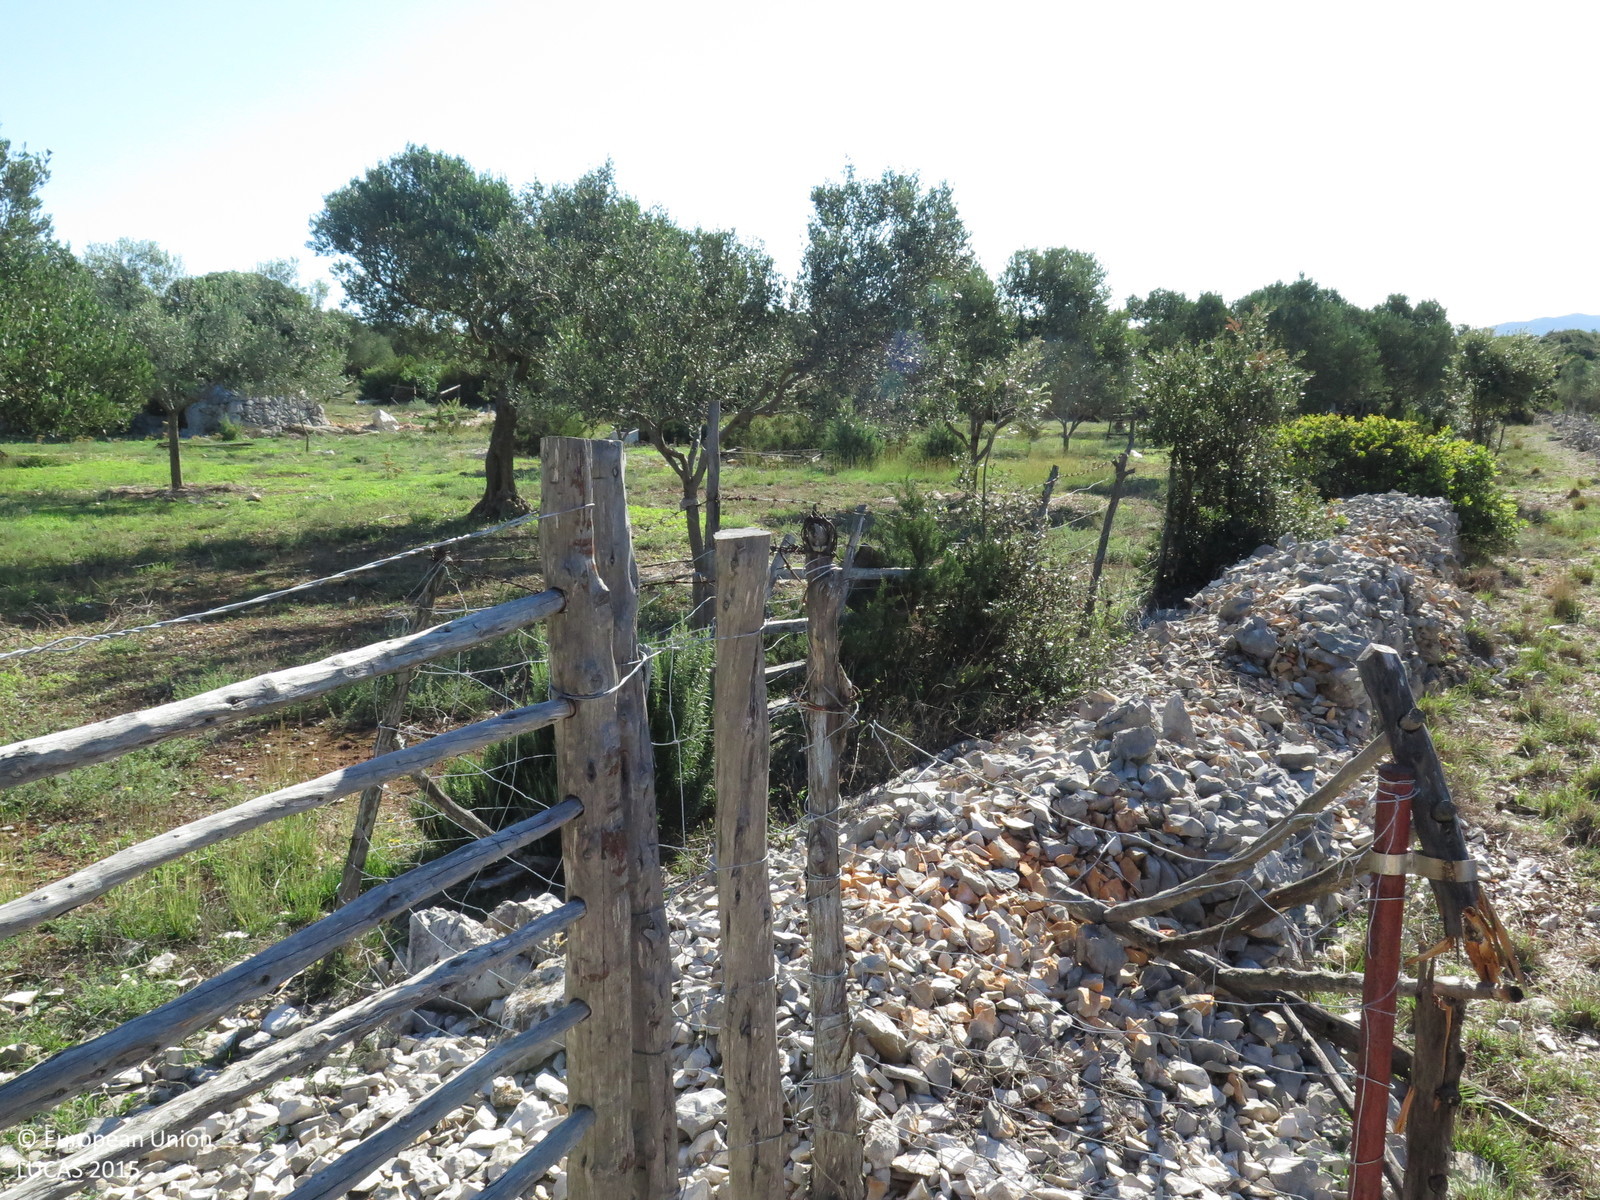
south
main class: Cropland
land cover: Olive groves
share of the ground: 25 - 50 %
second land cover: Grassland without tree/shrub cover
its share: > 75 %
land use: Agriculture (excluding fallow land and kitchen gardens)
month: September
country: HR
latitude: 44.5648
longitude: 14.3874
